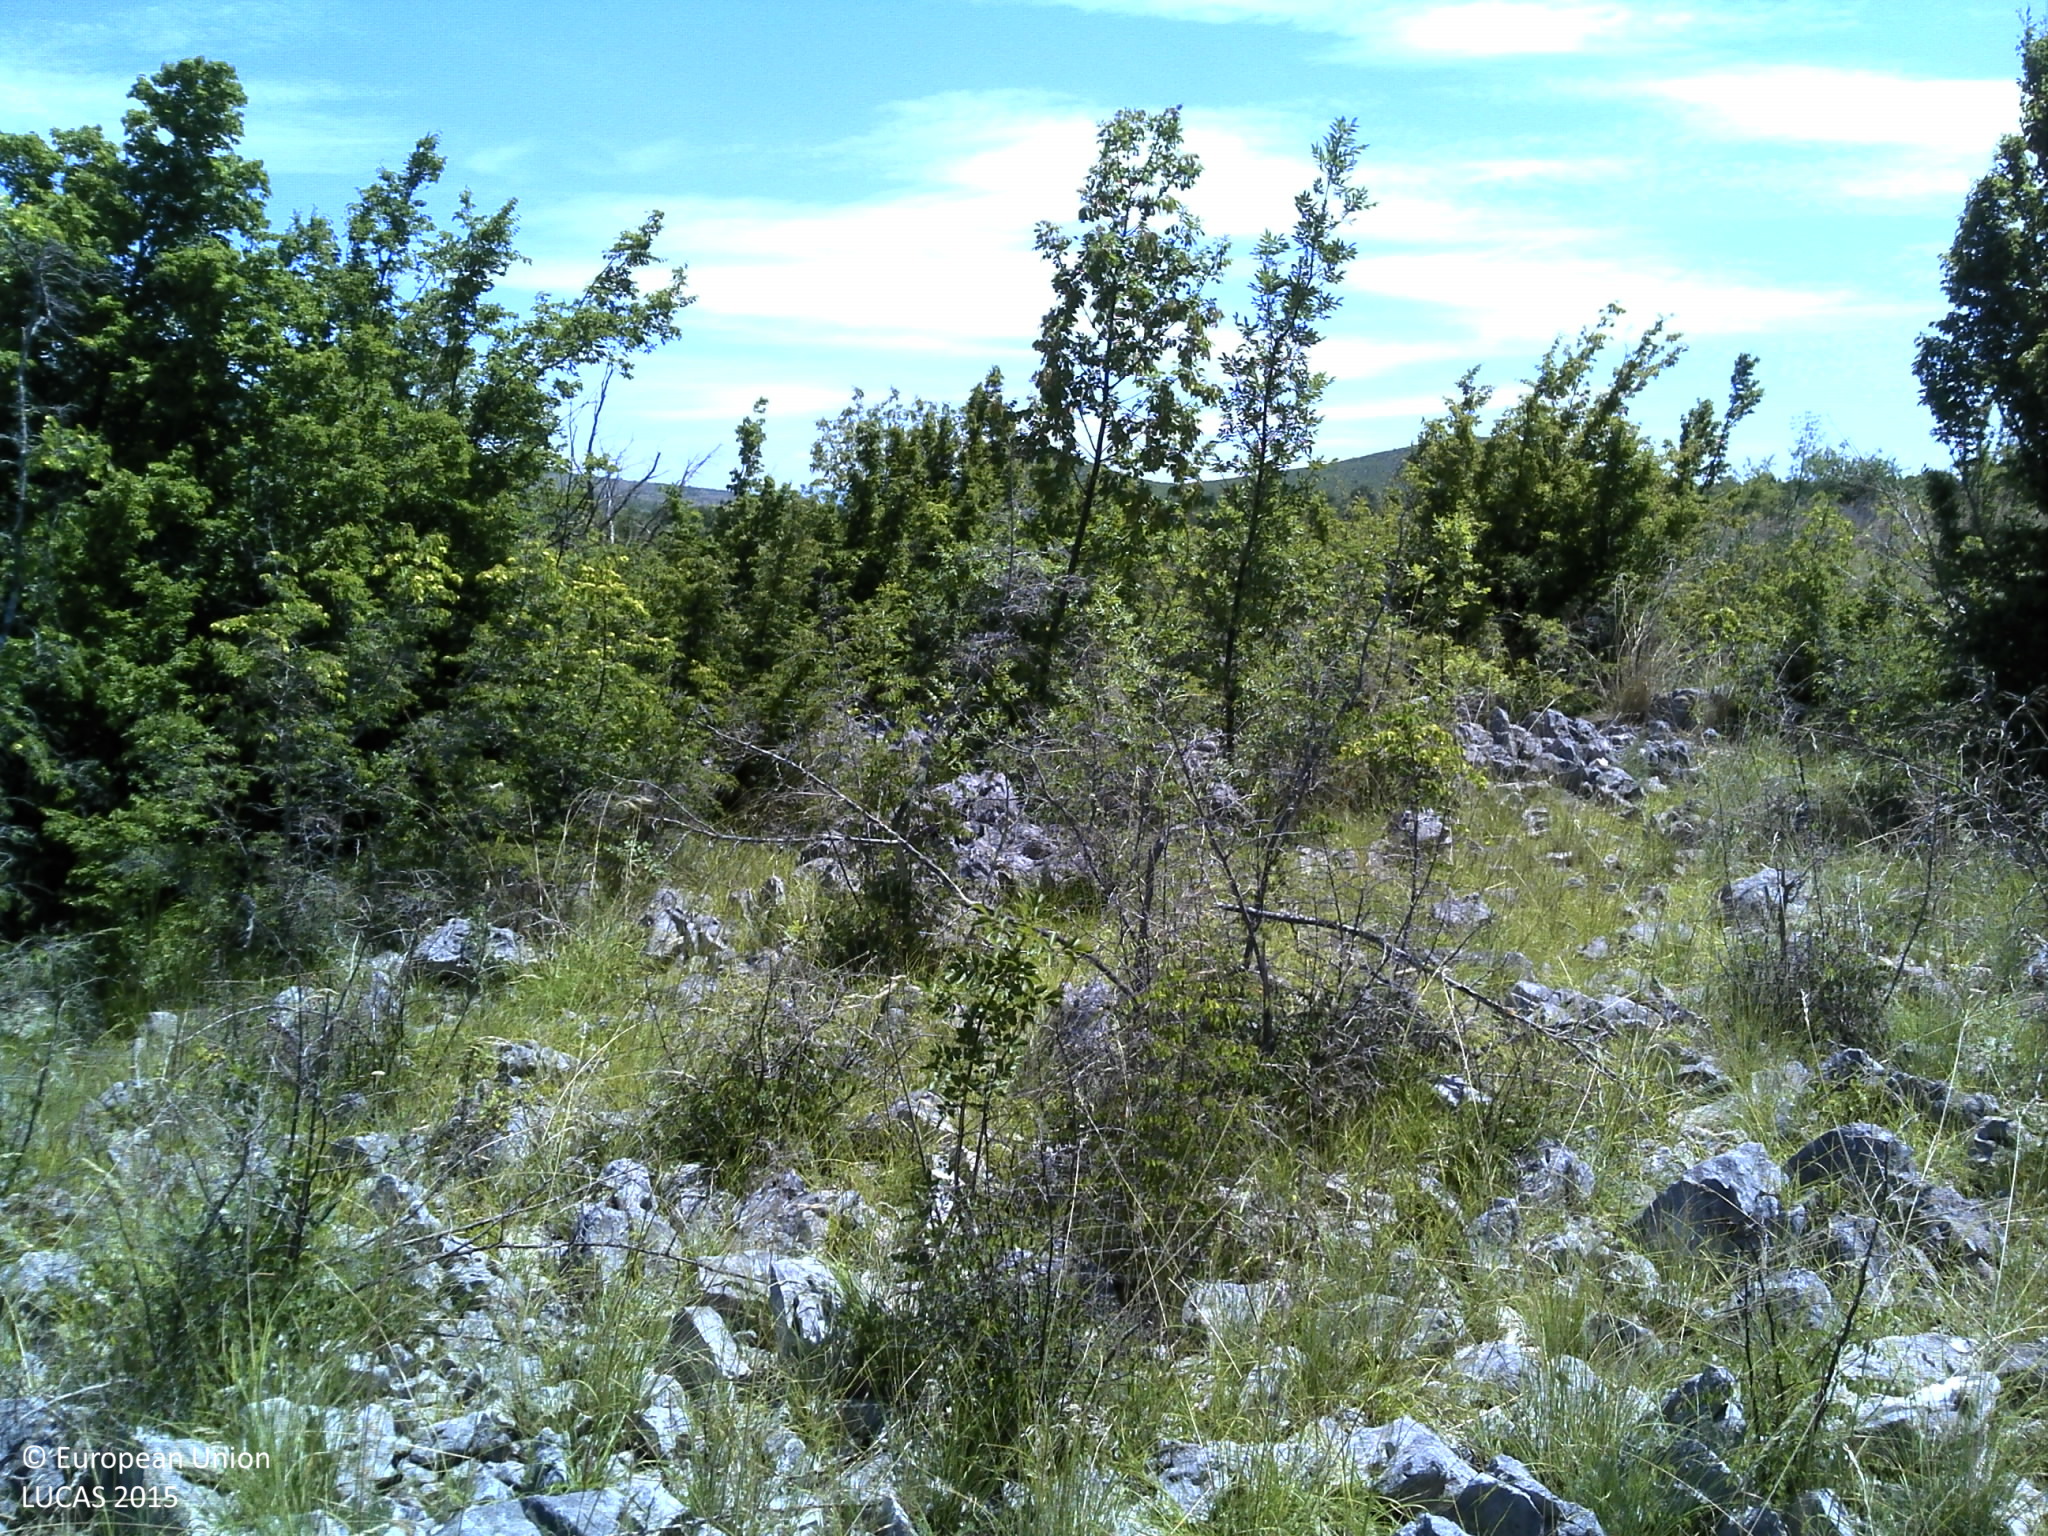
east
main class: Shrubland
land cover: Shrubland with sparse tree cover
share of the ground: 50 - 75 %
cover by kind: shrubs 35 %, unconsolidated bare surface 30 %, herbaceous plants 20 %, consolidated bare surface 10 %, broadleaved forest trees 5 %
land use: Semi-natural and natural areas not in use
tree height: < 5 m
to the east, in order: Shrubland with sparse tree cover; Dry stone walls; Shrubland with sparse tree cover; Grassland without tree/shrub cover; Shrubland with sparse tree cover; Vineyards; Grassland without tree/shrub cover; Shrubland with sparse tree cover; Clovers
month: June
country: HR
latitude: 44.0894
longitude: 15.9499
